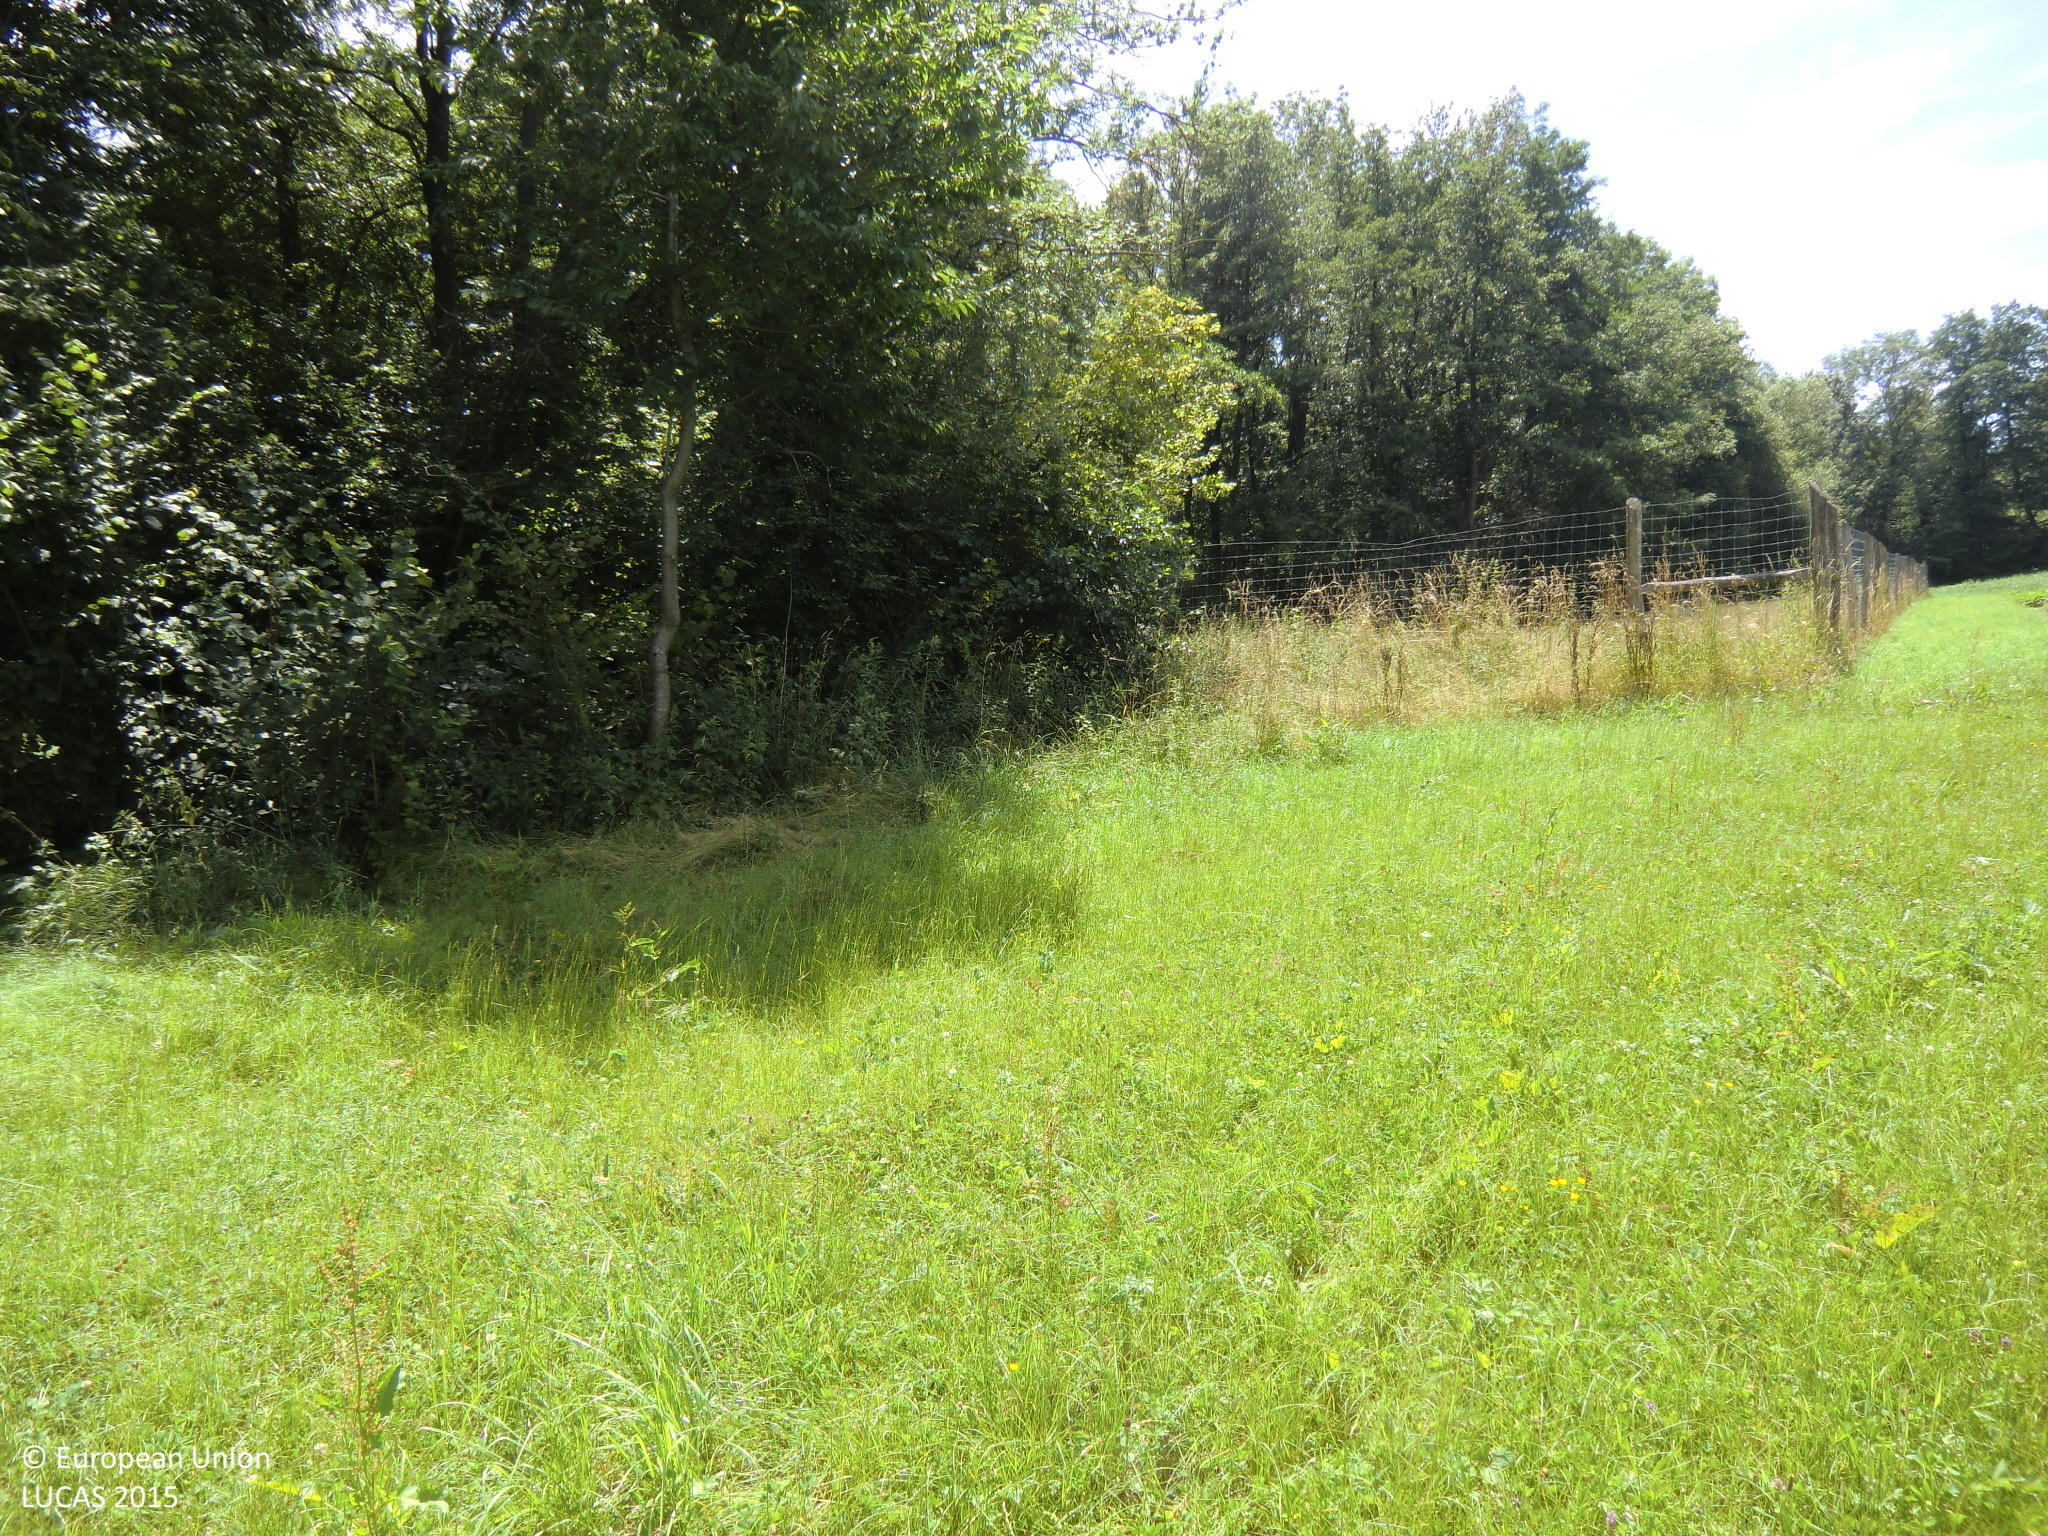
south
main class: Grassland
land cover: Grassland without tree/shrub cover
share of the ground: > 75 %
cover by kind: herbaceous plants 100 %
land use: Agriculture (excluding fallow land and kitchen gardens)
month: July
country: AT
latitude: 47.1042
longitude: 15.6532
